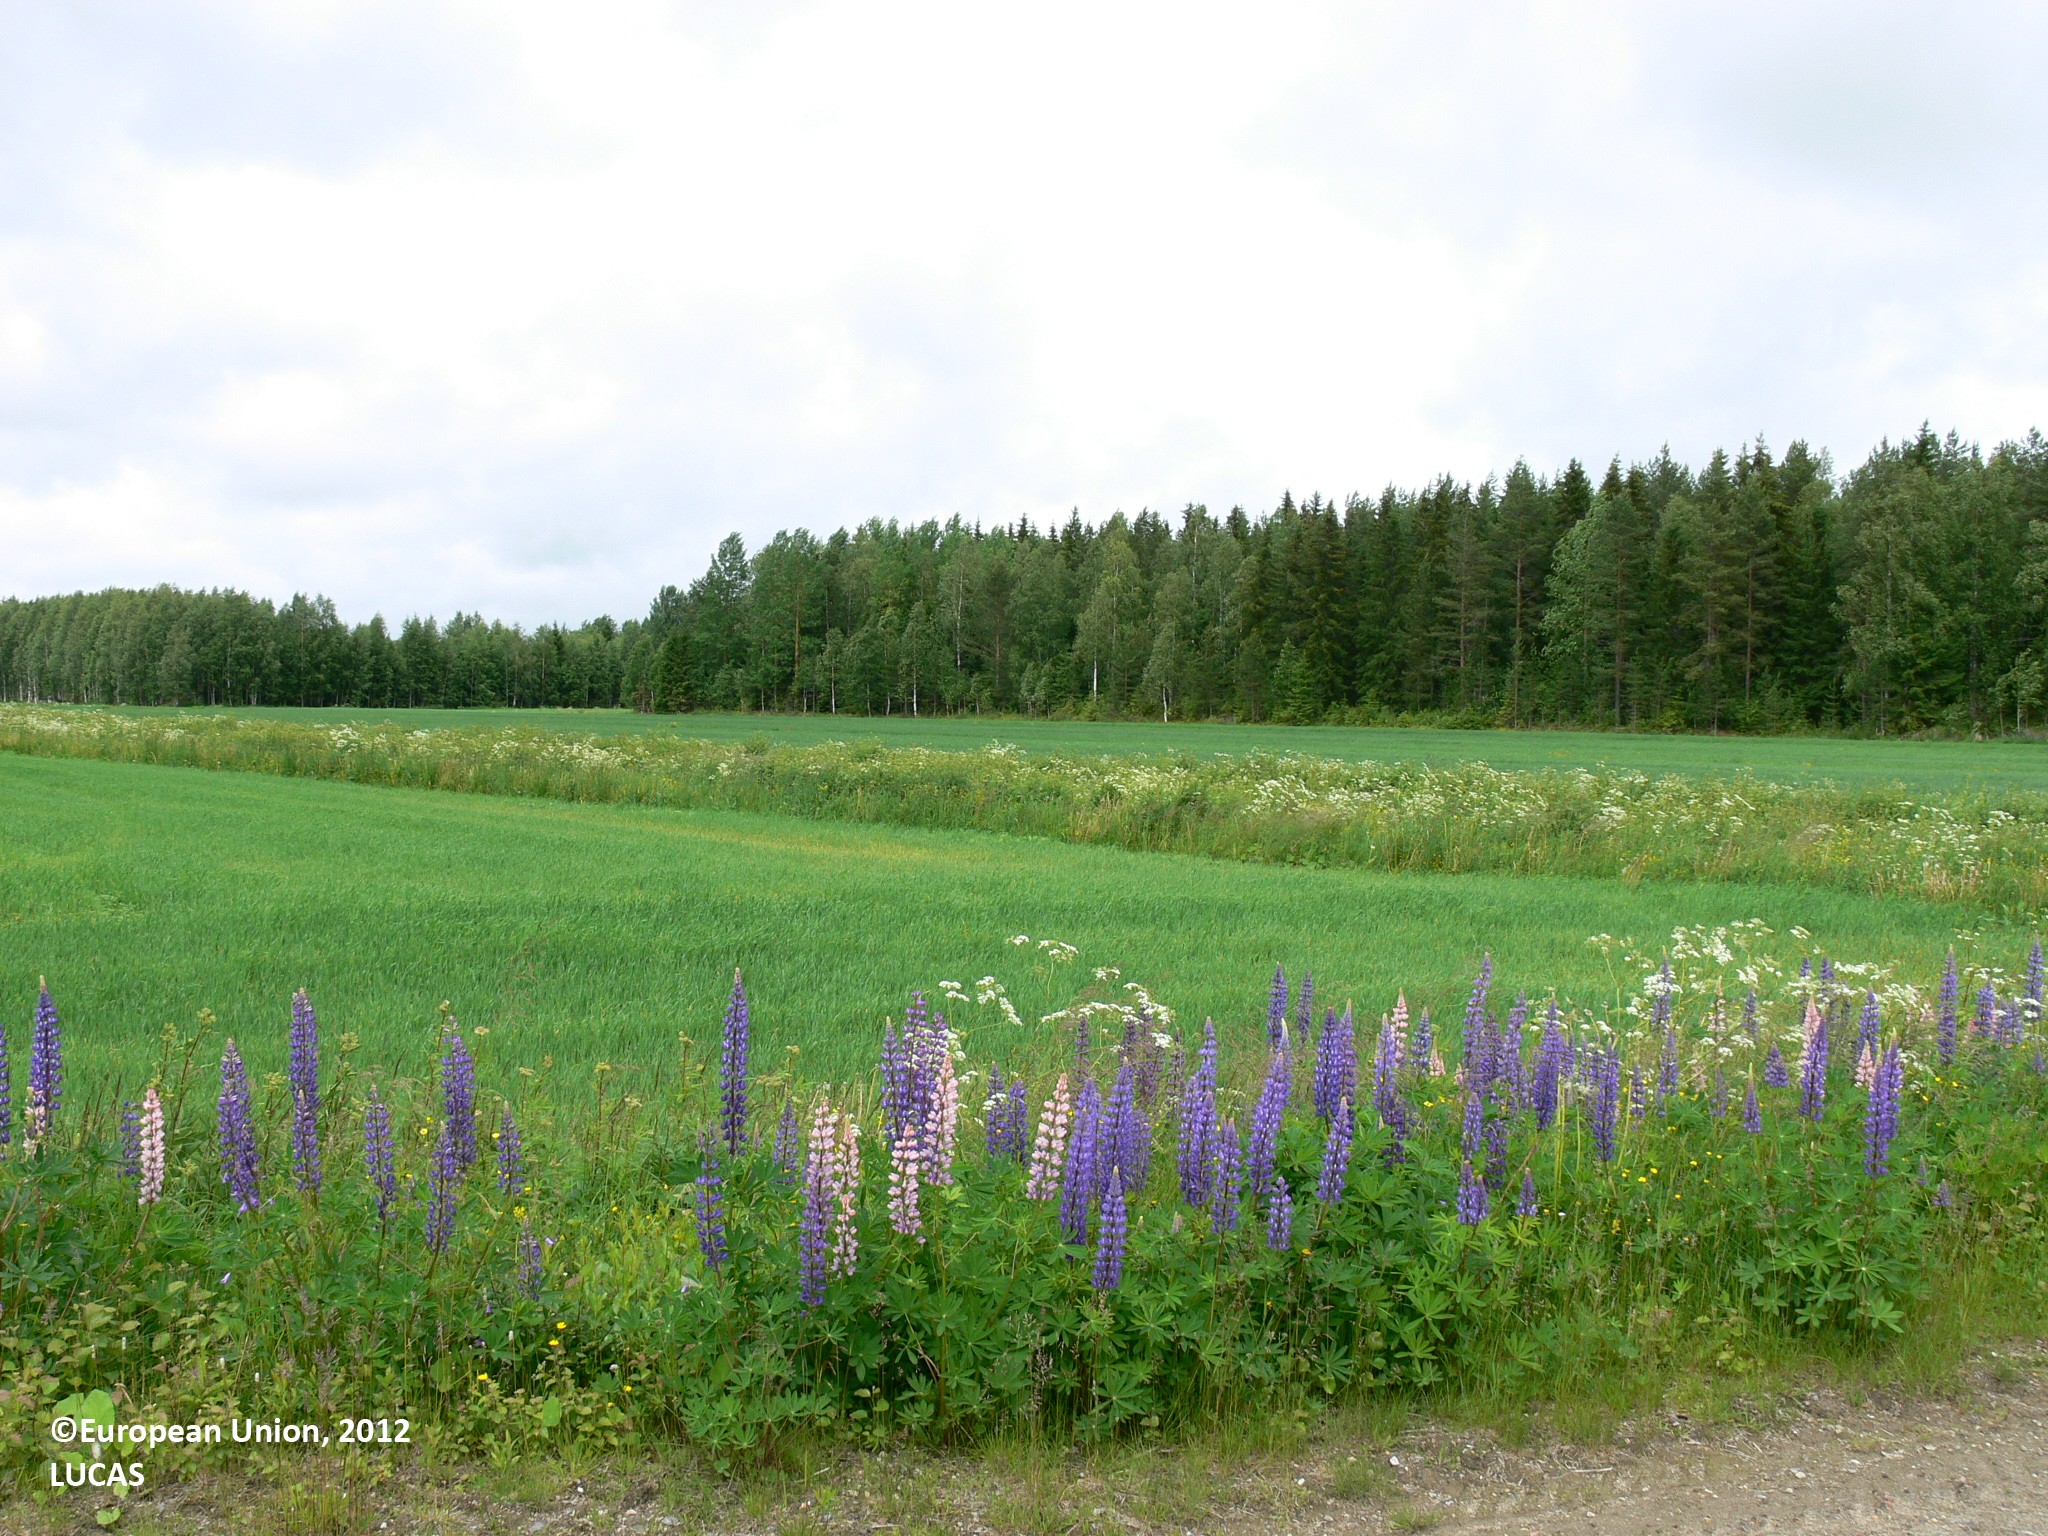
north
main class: Cropland
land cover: Barley
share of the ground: > 75 %
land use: Agriculture (excluding fallow land and kitchen gardens)
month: June
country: FI
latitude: 62.8216
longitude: 29.2819
